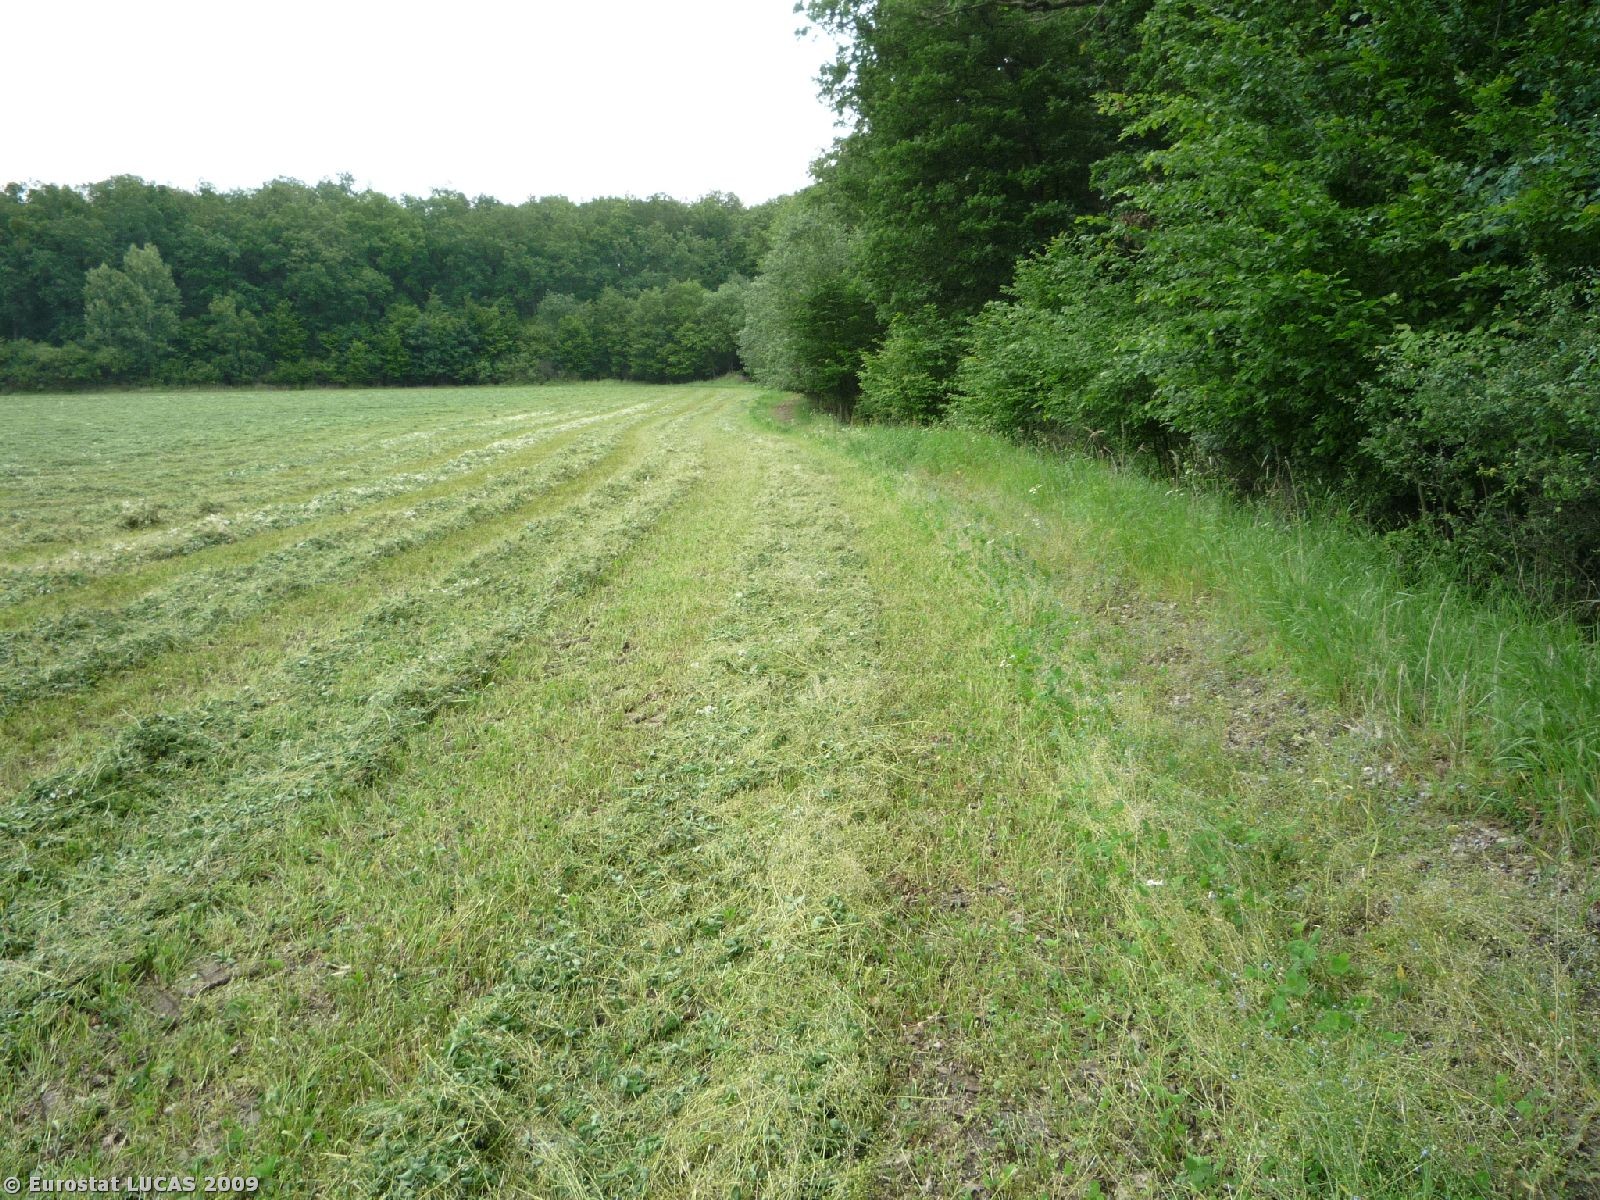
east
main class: Cropland
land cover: Clovers
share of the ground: > 75 %
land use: Agriculture (excluding fallow land and kitchen gardens)
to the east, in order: Clovers; Grass margins; Broadleaved woodland; Ditches and canals; Broadleaved woodland
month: May
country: CZ
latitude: 50.3028
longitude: 15.5218
